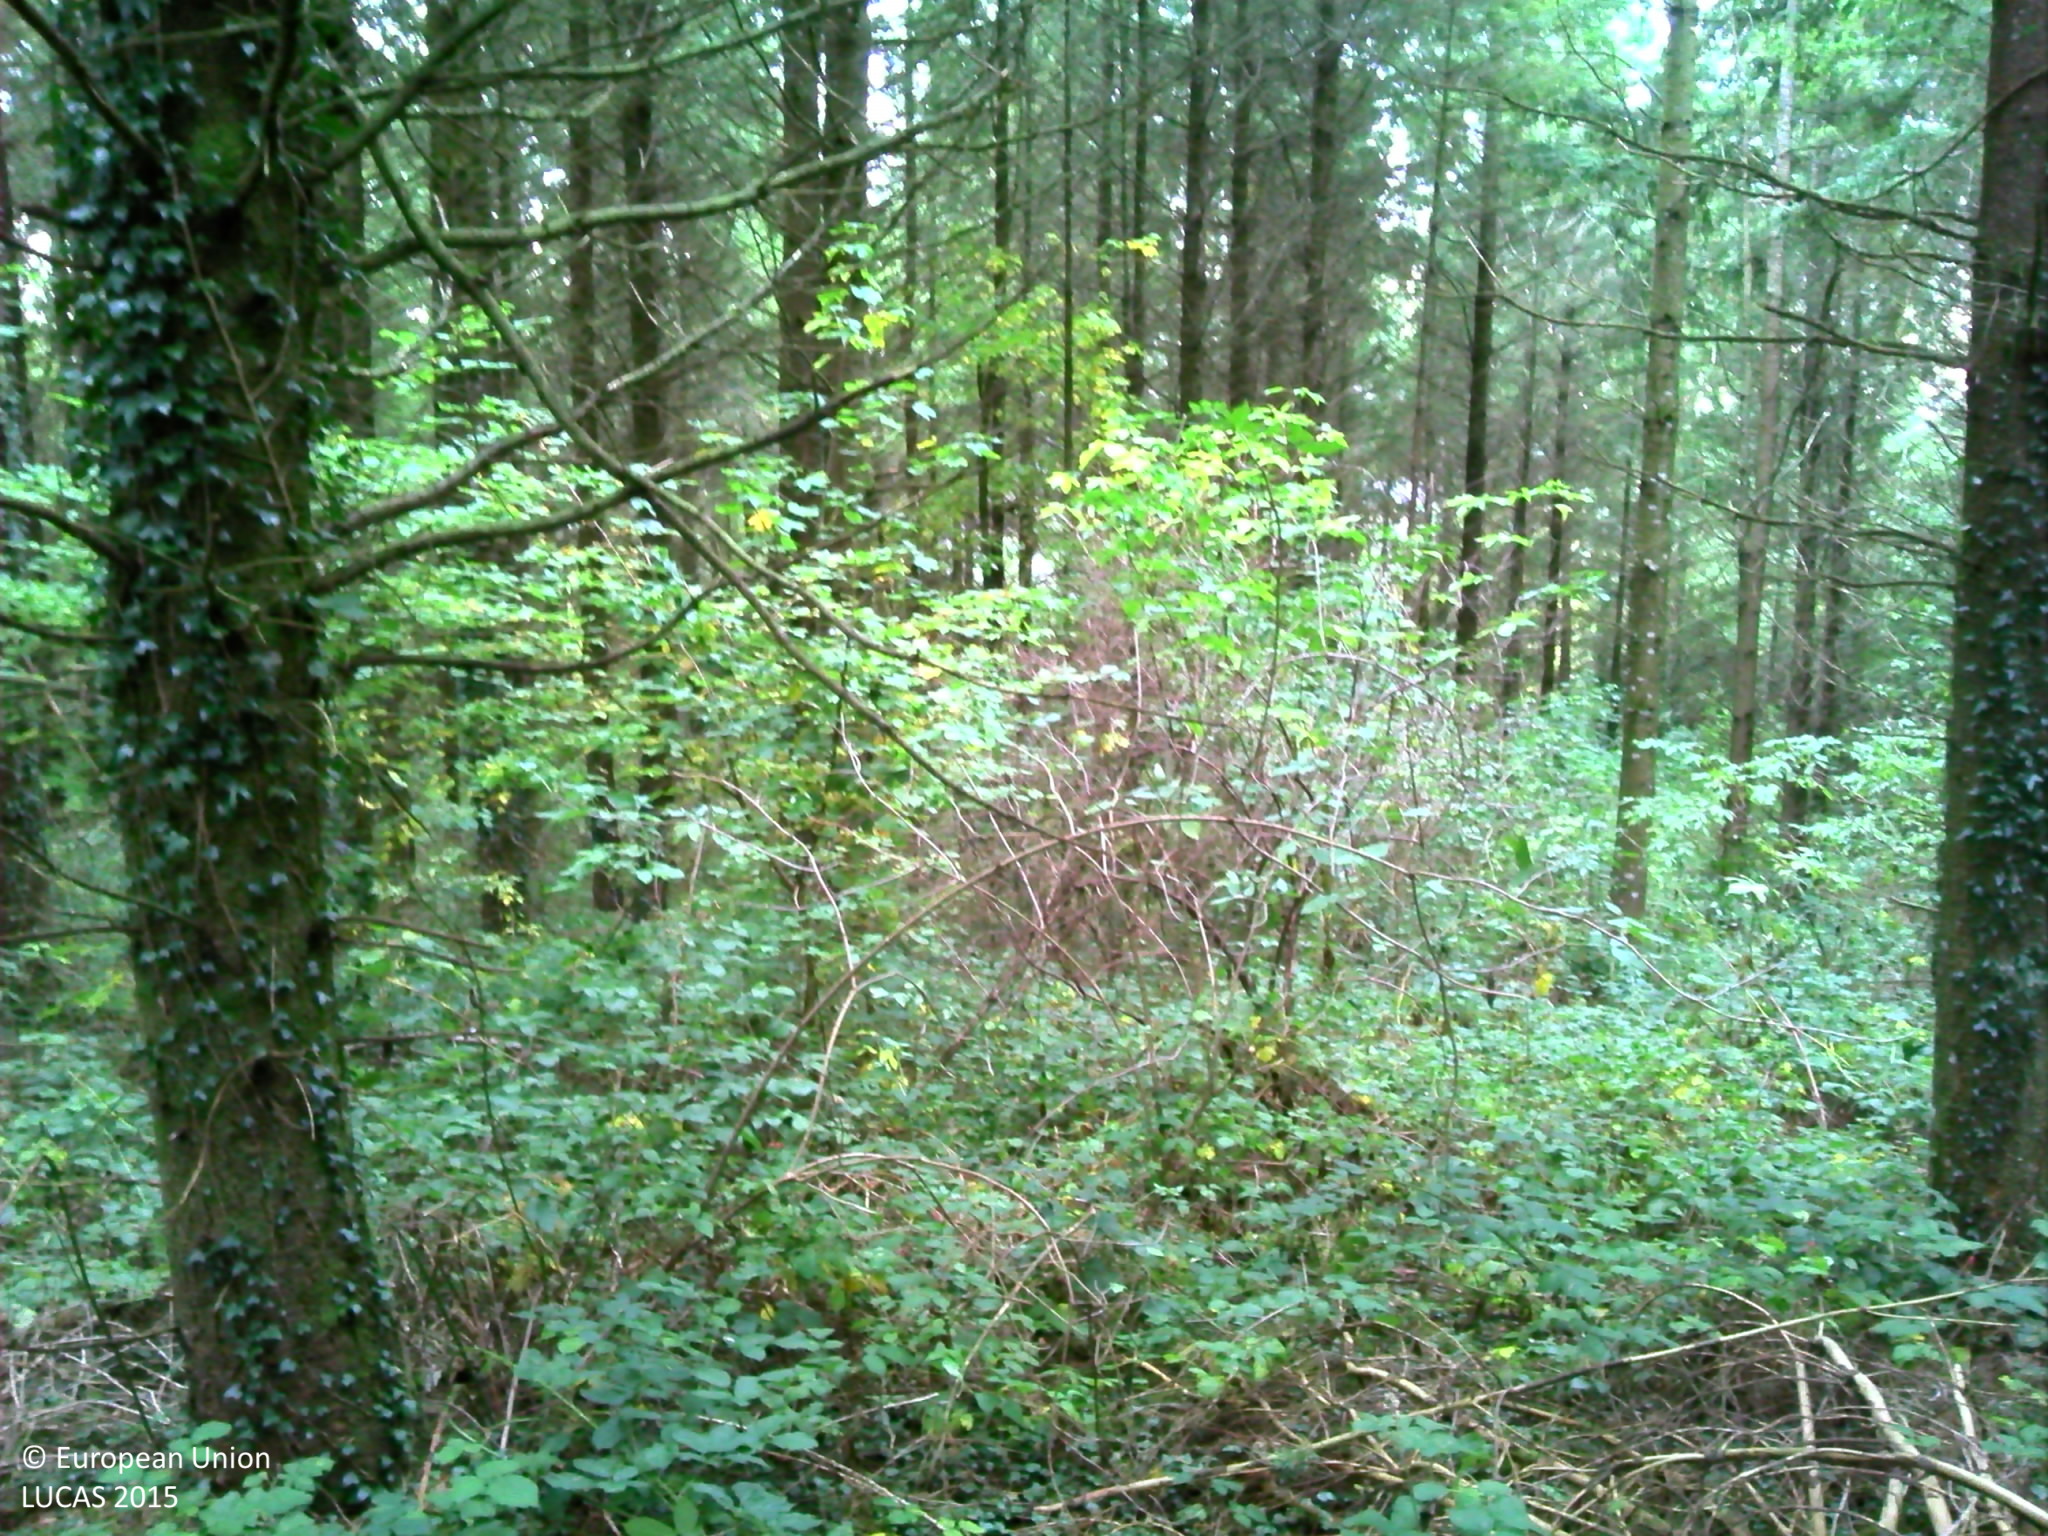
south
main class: Woodland
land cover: Other coniferous woodland
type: exotic forest
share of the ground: > 75 %
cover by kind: coniferous forest trees 80 %, herbaceous plants 15 %, broadleaved forest trees 5 %
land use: Forestry
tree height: > 5 m
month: October
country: FR
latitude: 45.9627
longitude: 2.7848
